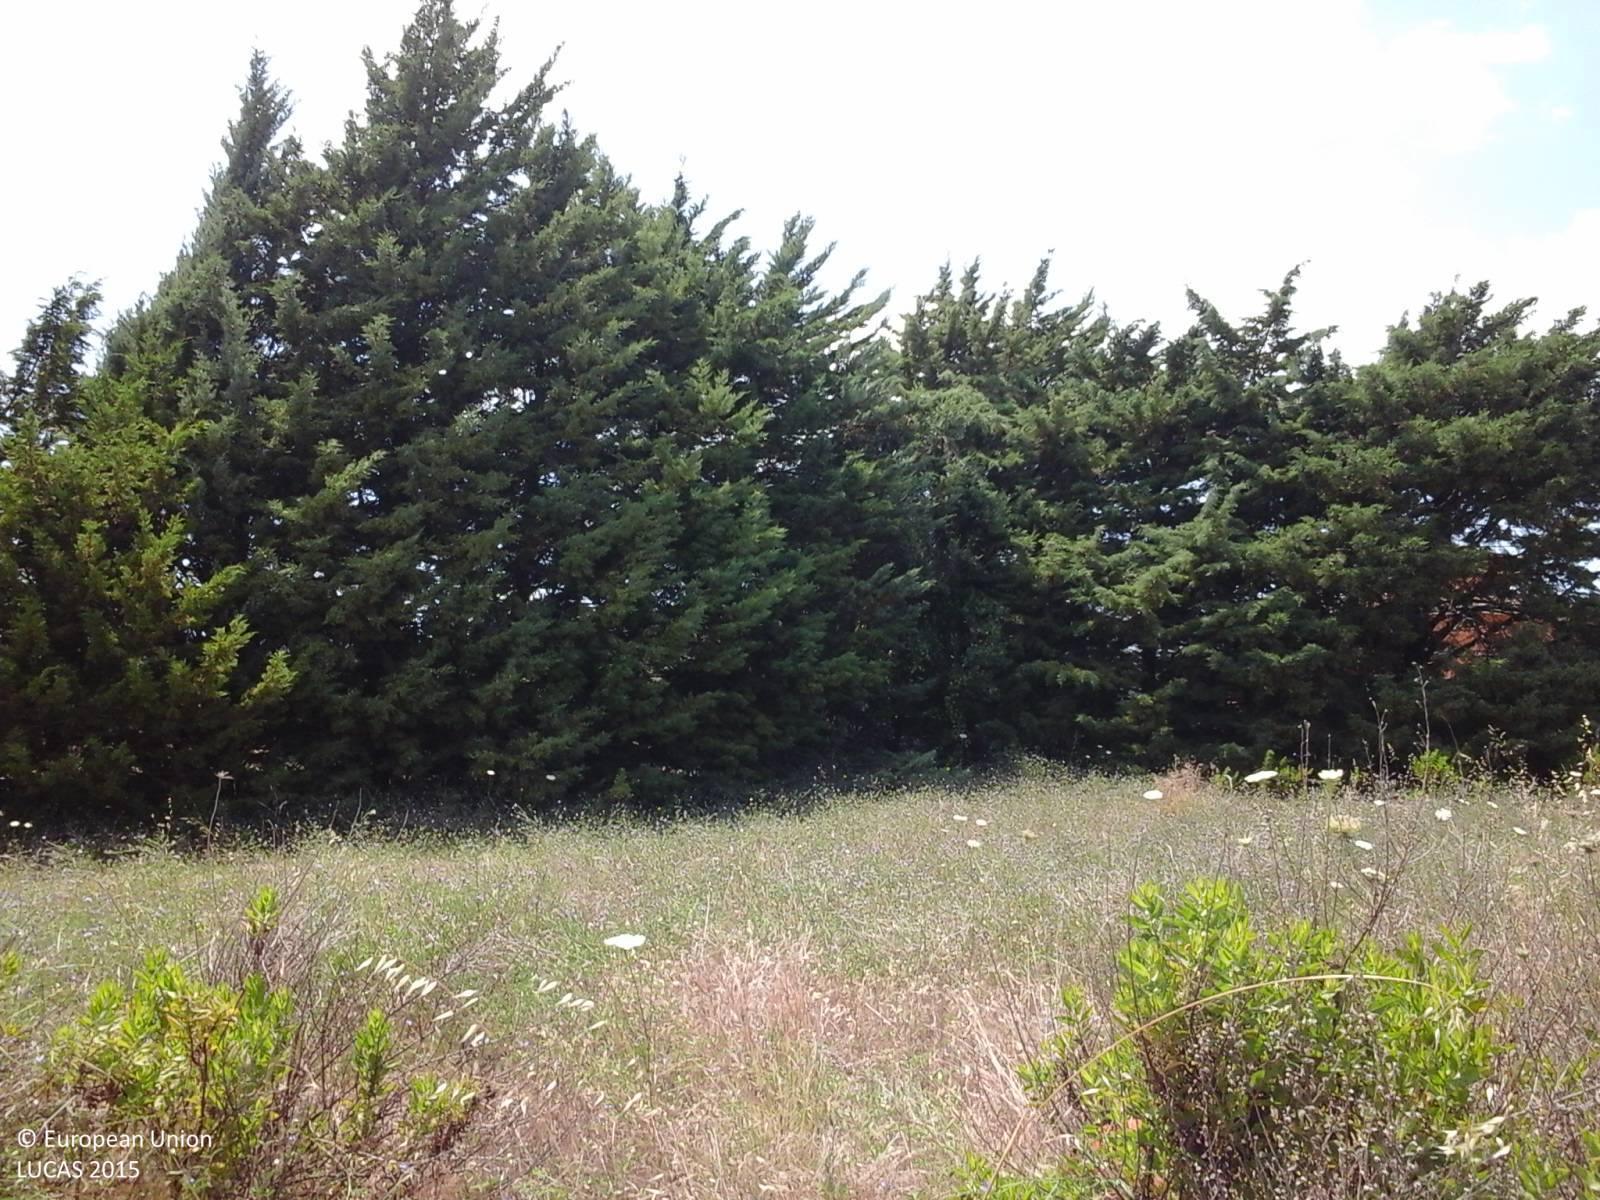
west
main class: Grassland
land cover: Grassland without tree/shrub cover
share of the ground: > 75 %
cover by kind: herbaceous plants 100 %
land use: Abandoned areas
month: June
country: IT
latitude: 38.0243
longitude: 13.0879
